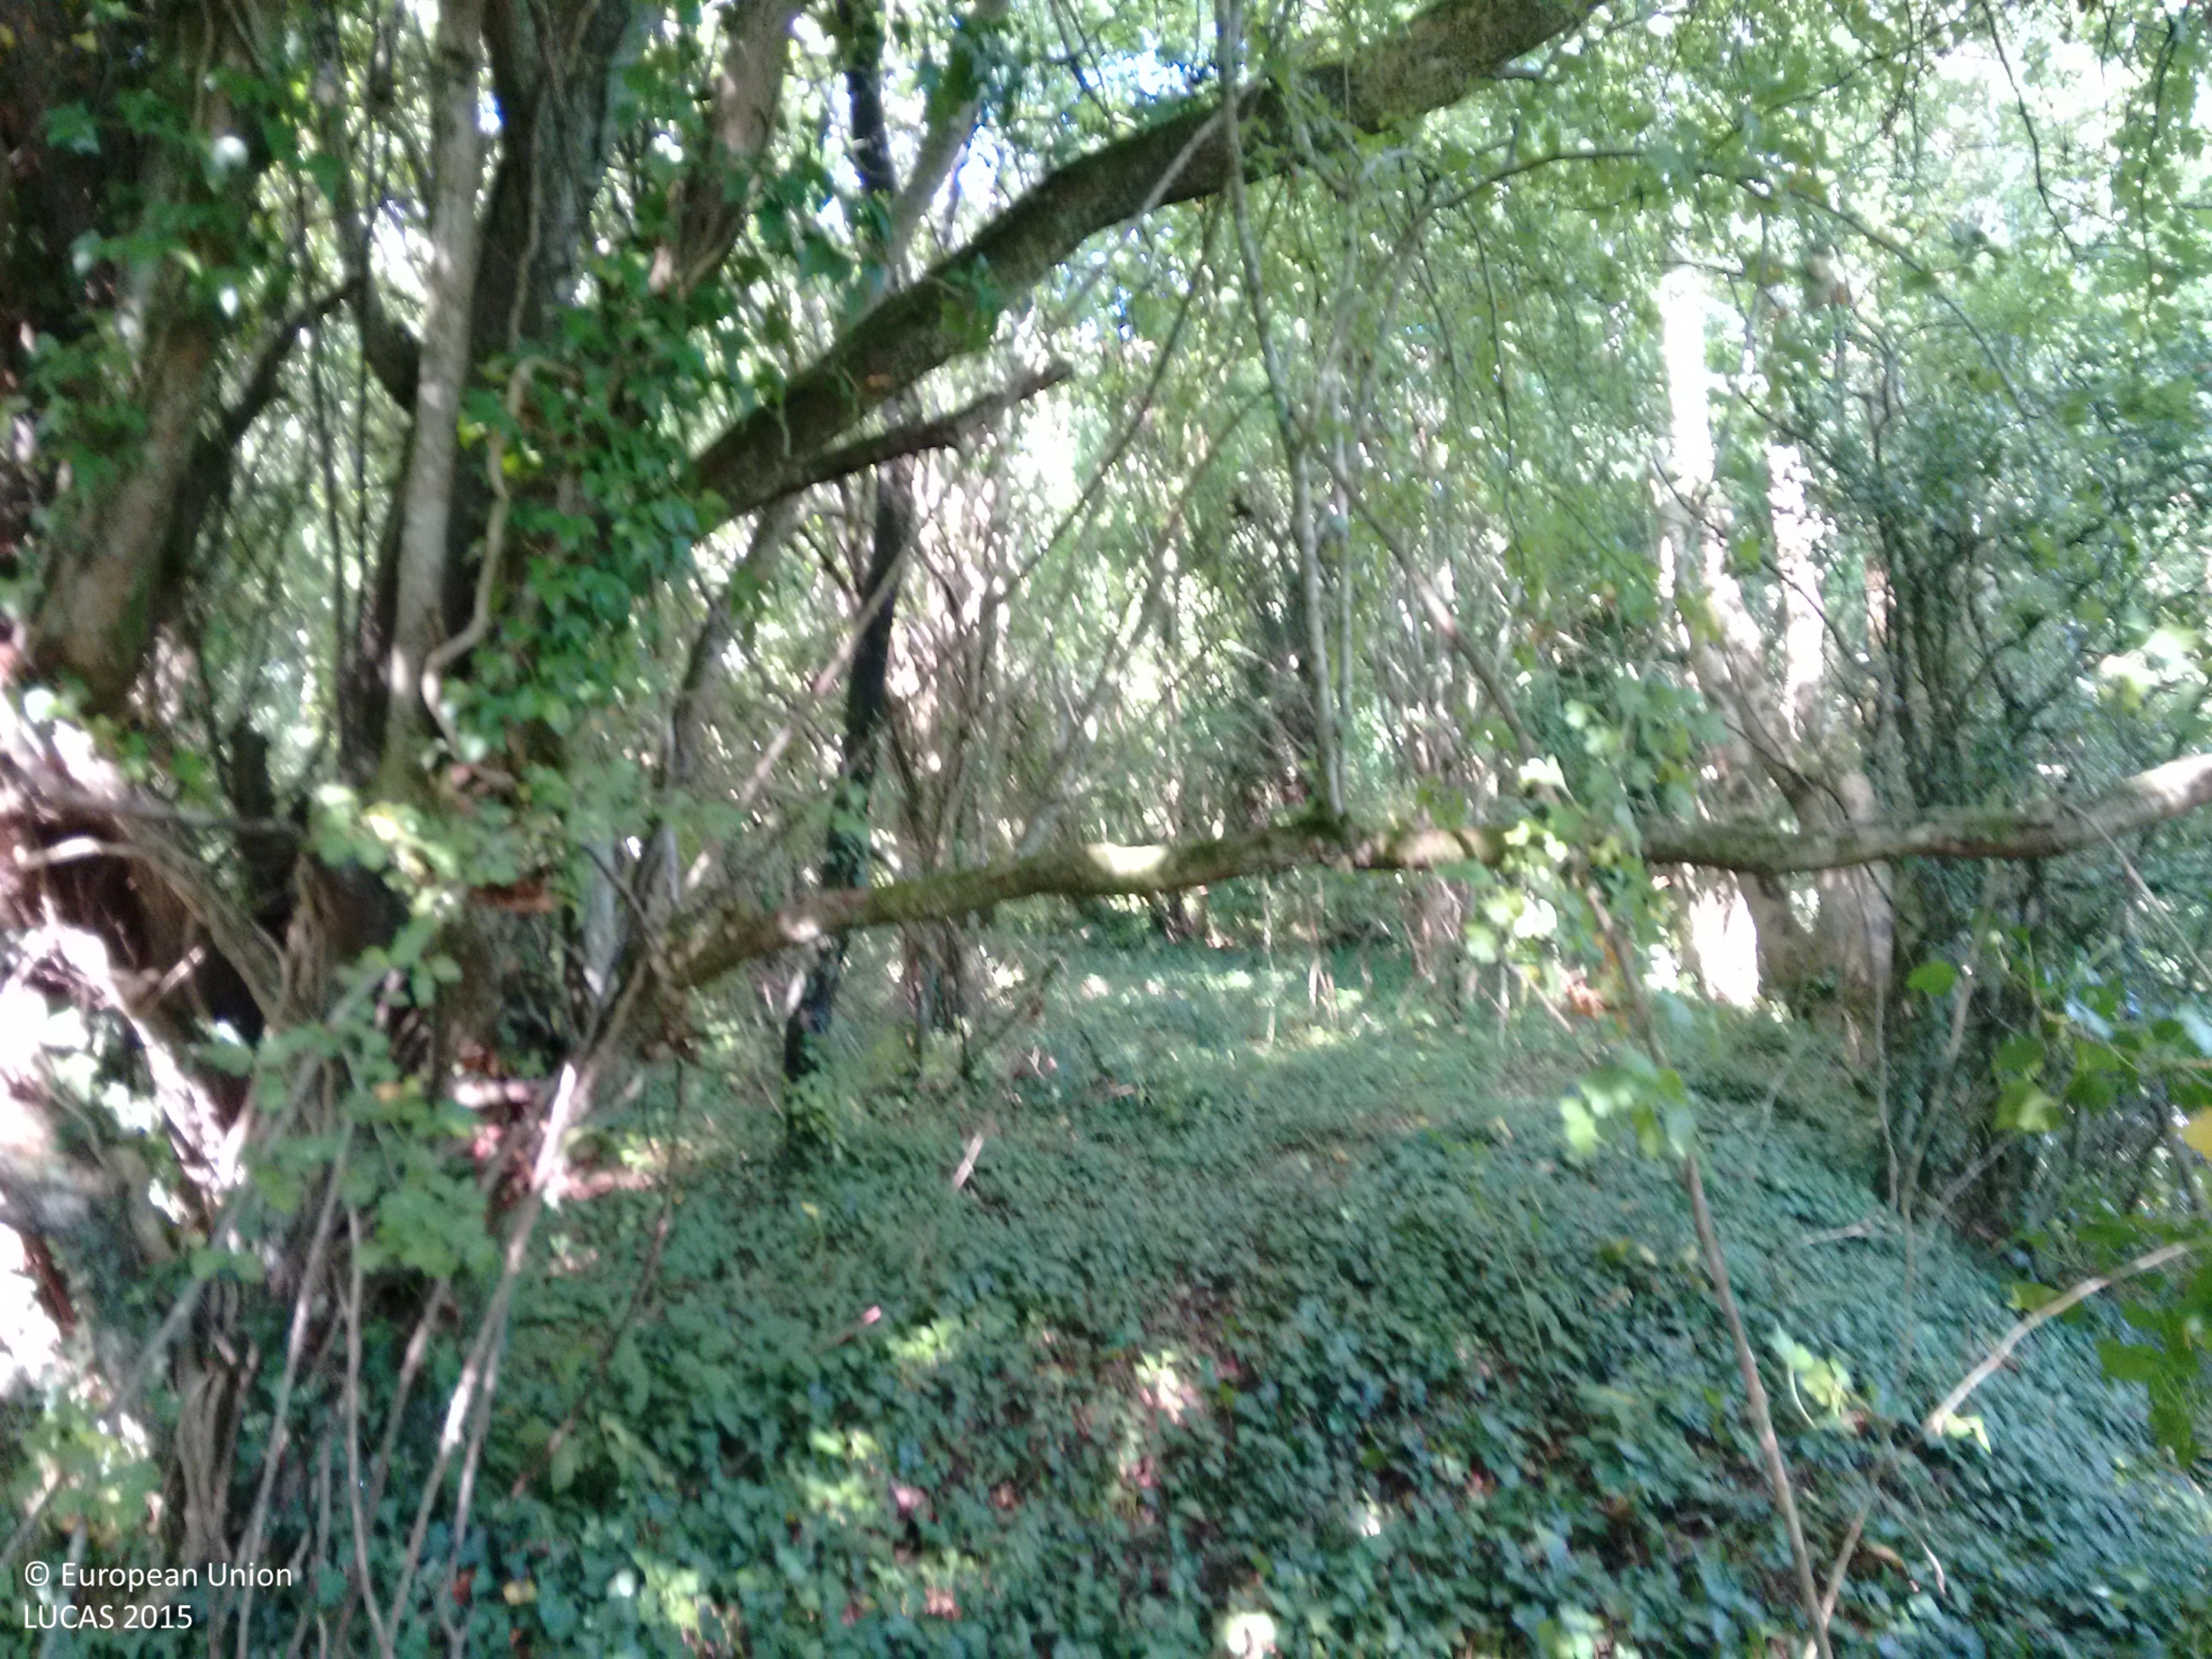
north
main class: Woodland
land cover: Broadleaved woodland
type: acidophilous oak and oak-birch forest
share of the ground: > 75 %
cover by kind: broadleaved forest trees 95 %, herbaceous plants 5 %
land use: Semi-natural and natural areas not in use
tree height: > 5 m
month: September
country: IE
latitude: 52.6960
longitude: -8.6204
